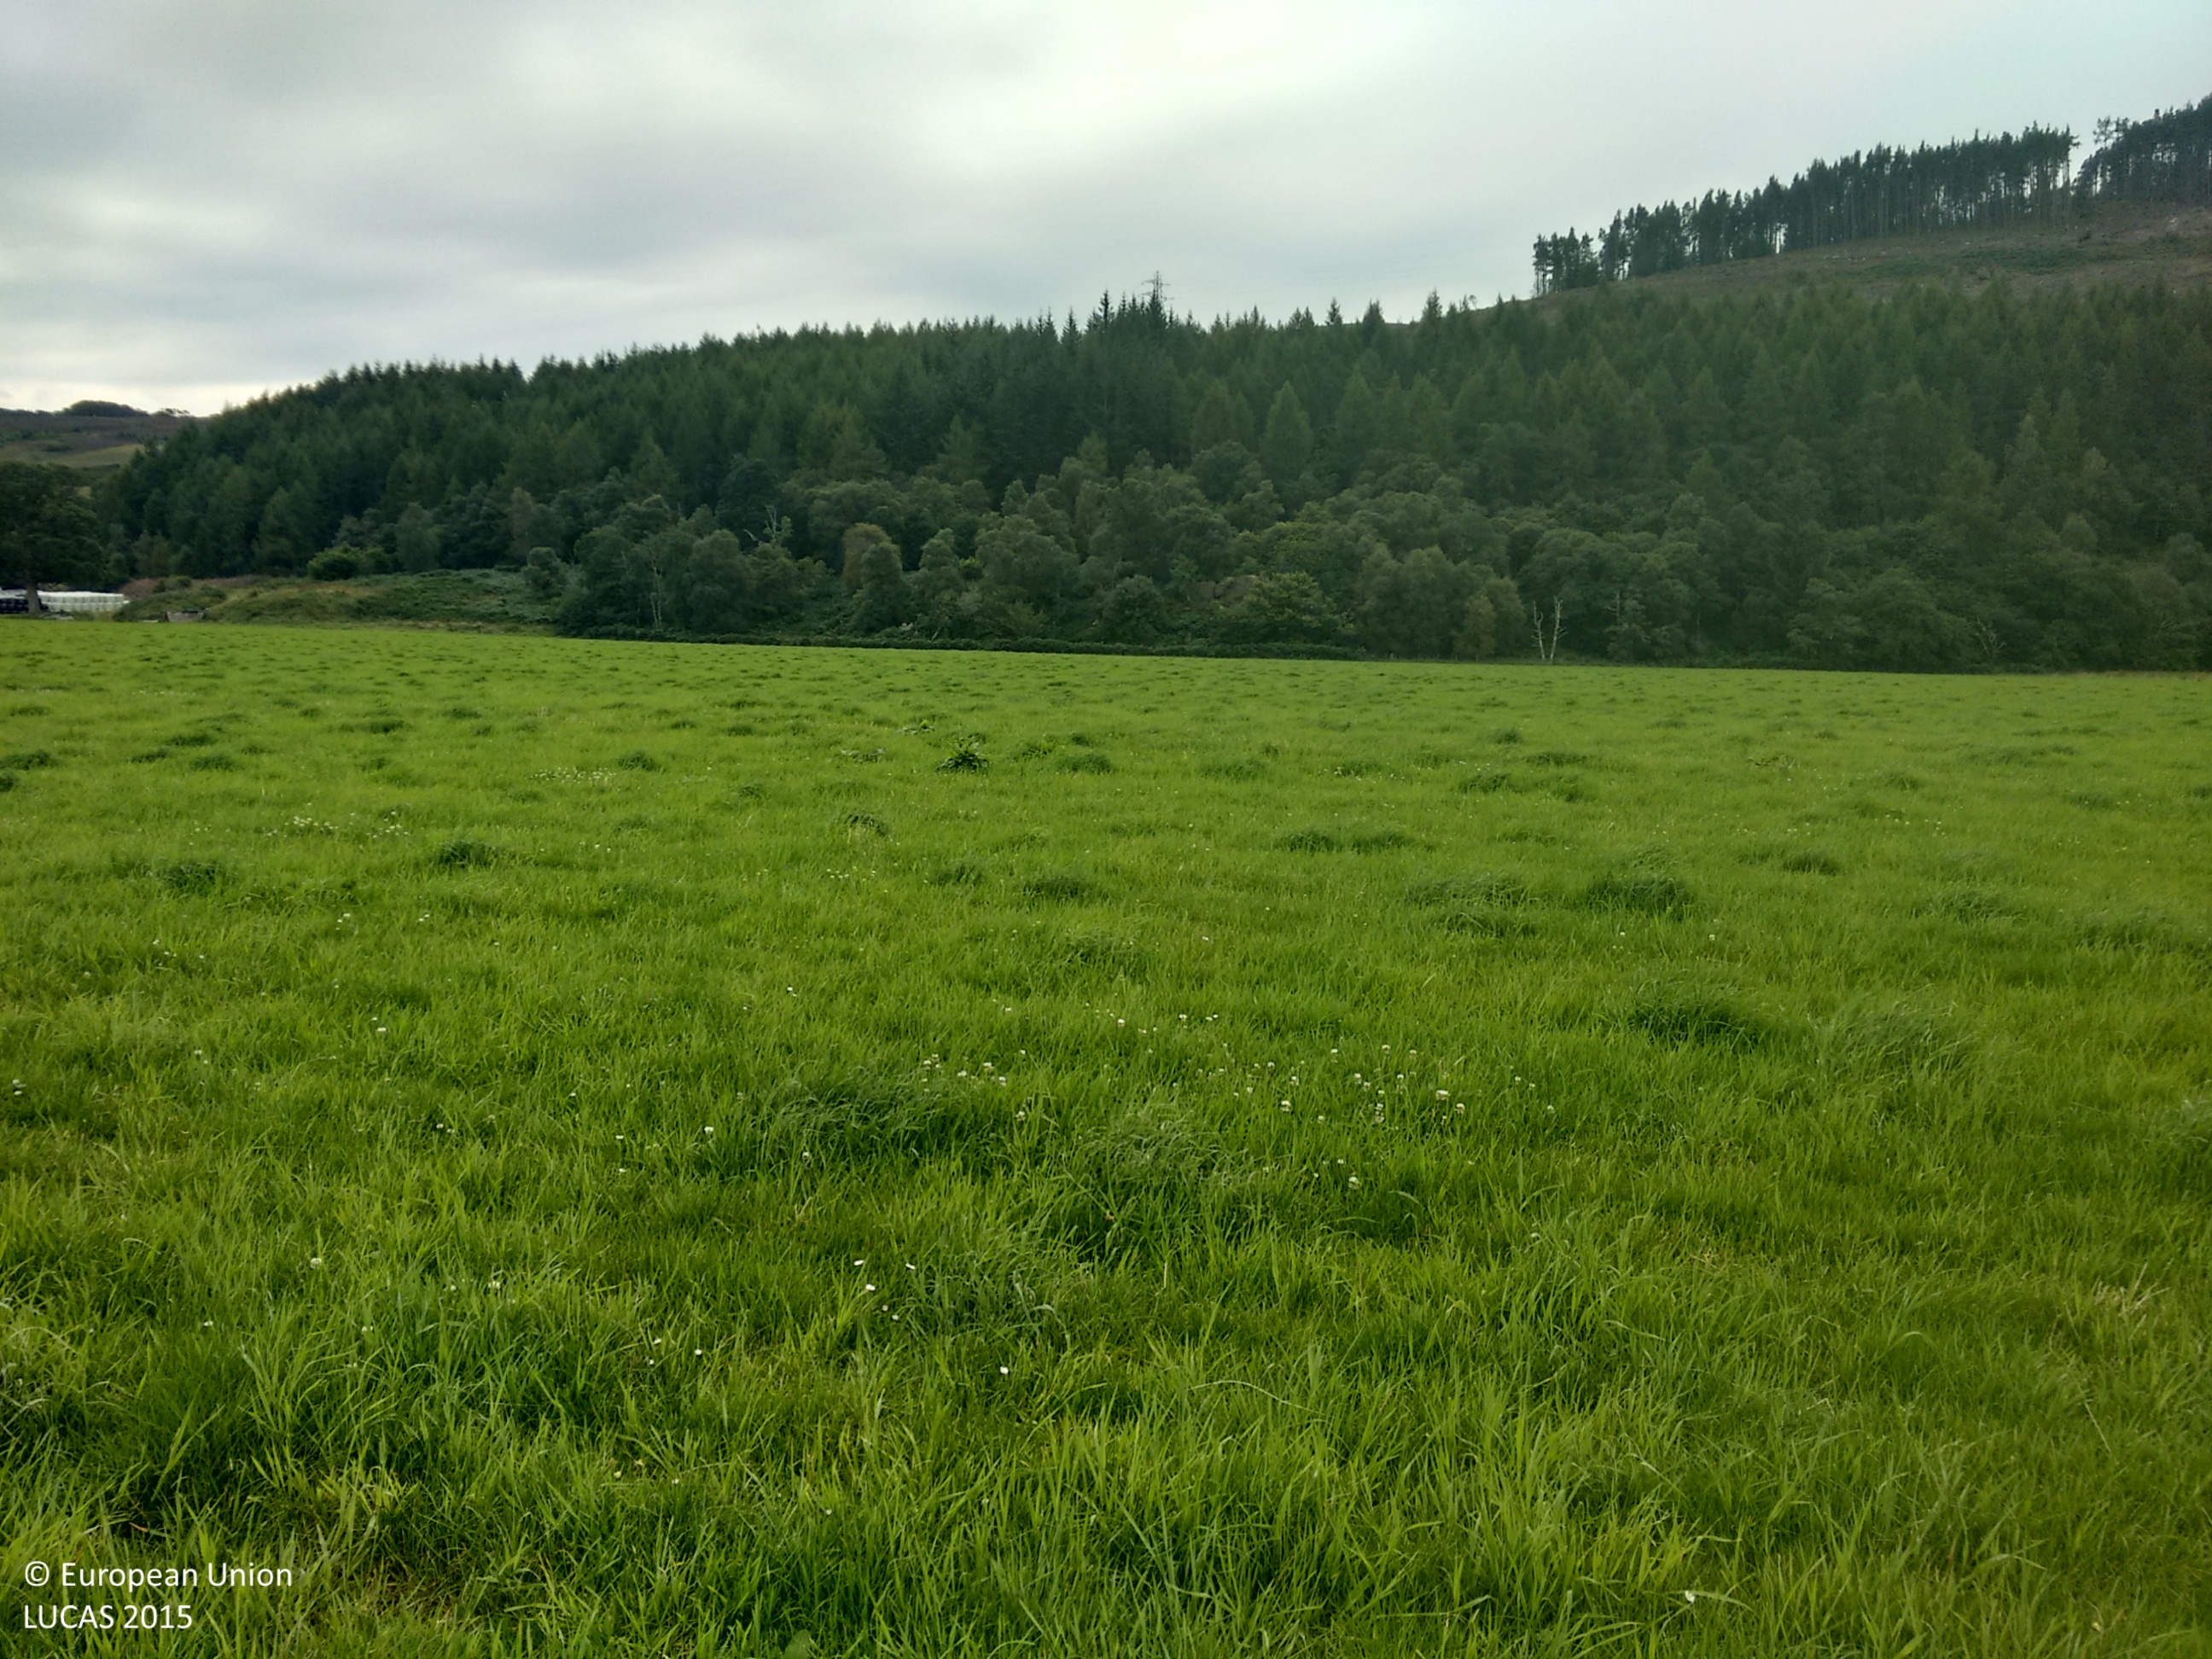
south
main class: Grassland
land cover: Grassland without tree/shrub cover
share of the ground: > 75 %
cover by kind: herbaceous plants 100 %
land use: Agriculture (excluding fallow land and kitchen gardens)
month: September
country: GB
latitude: 57.8532
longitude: -4.2893
